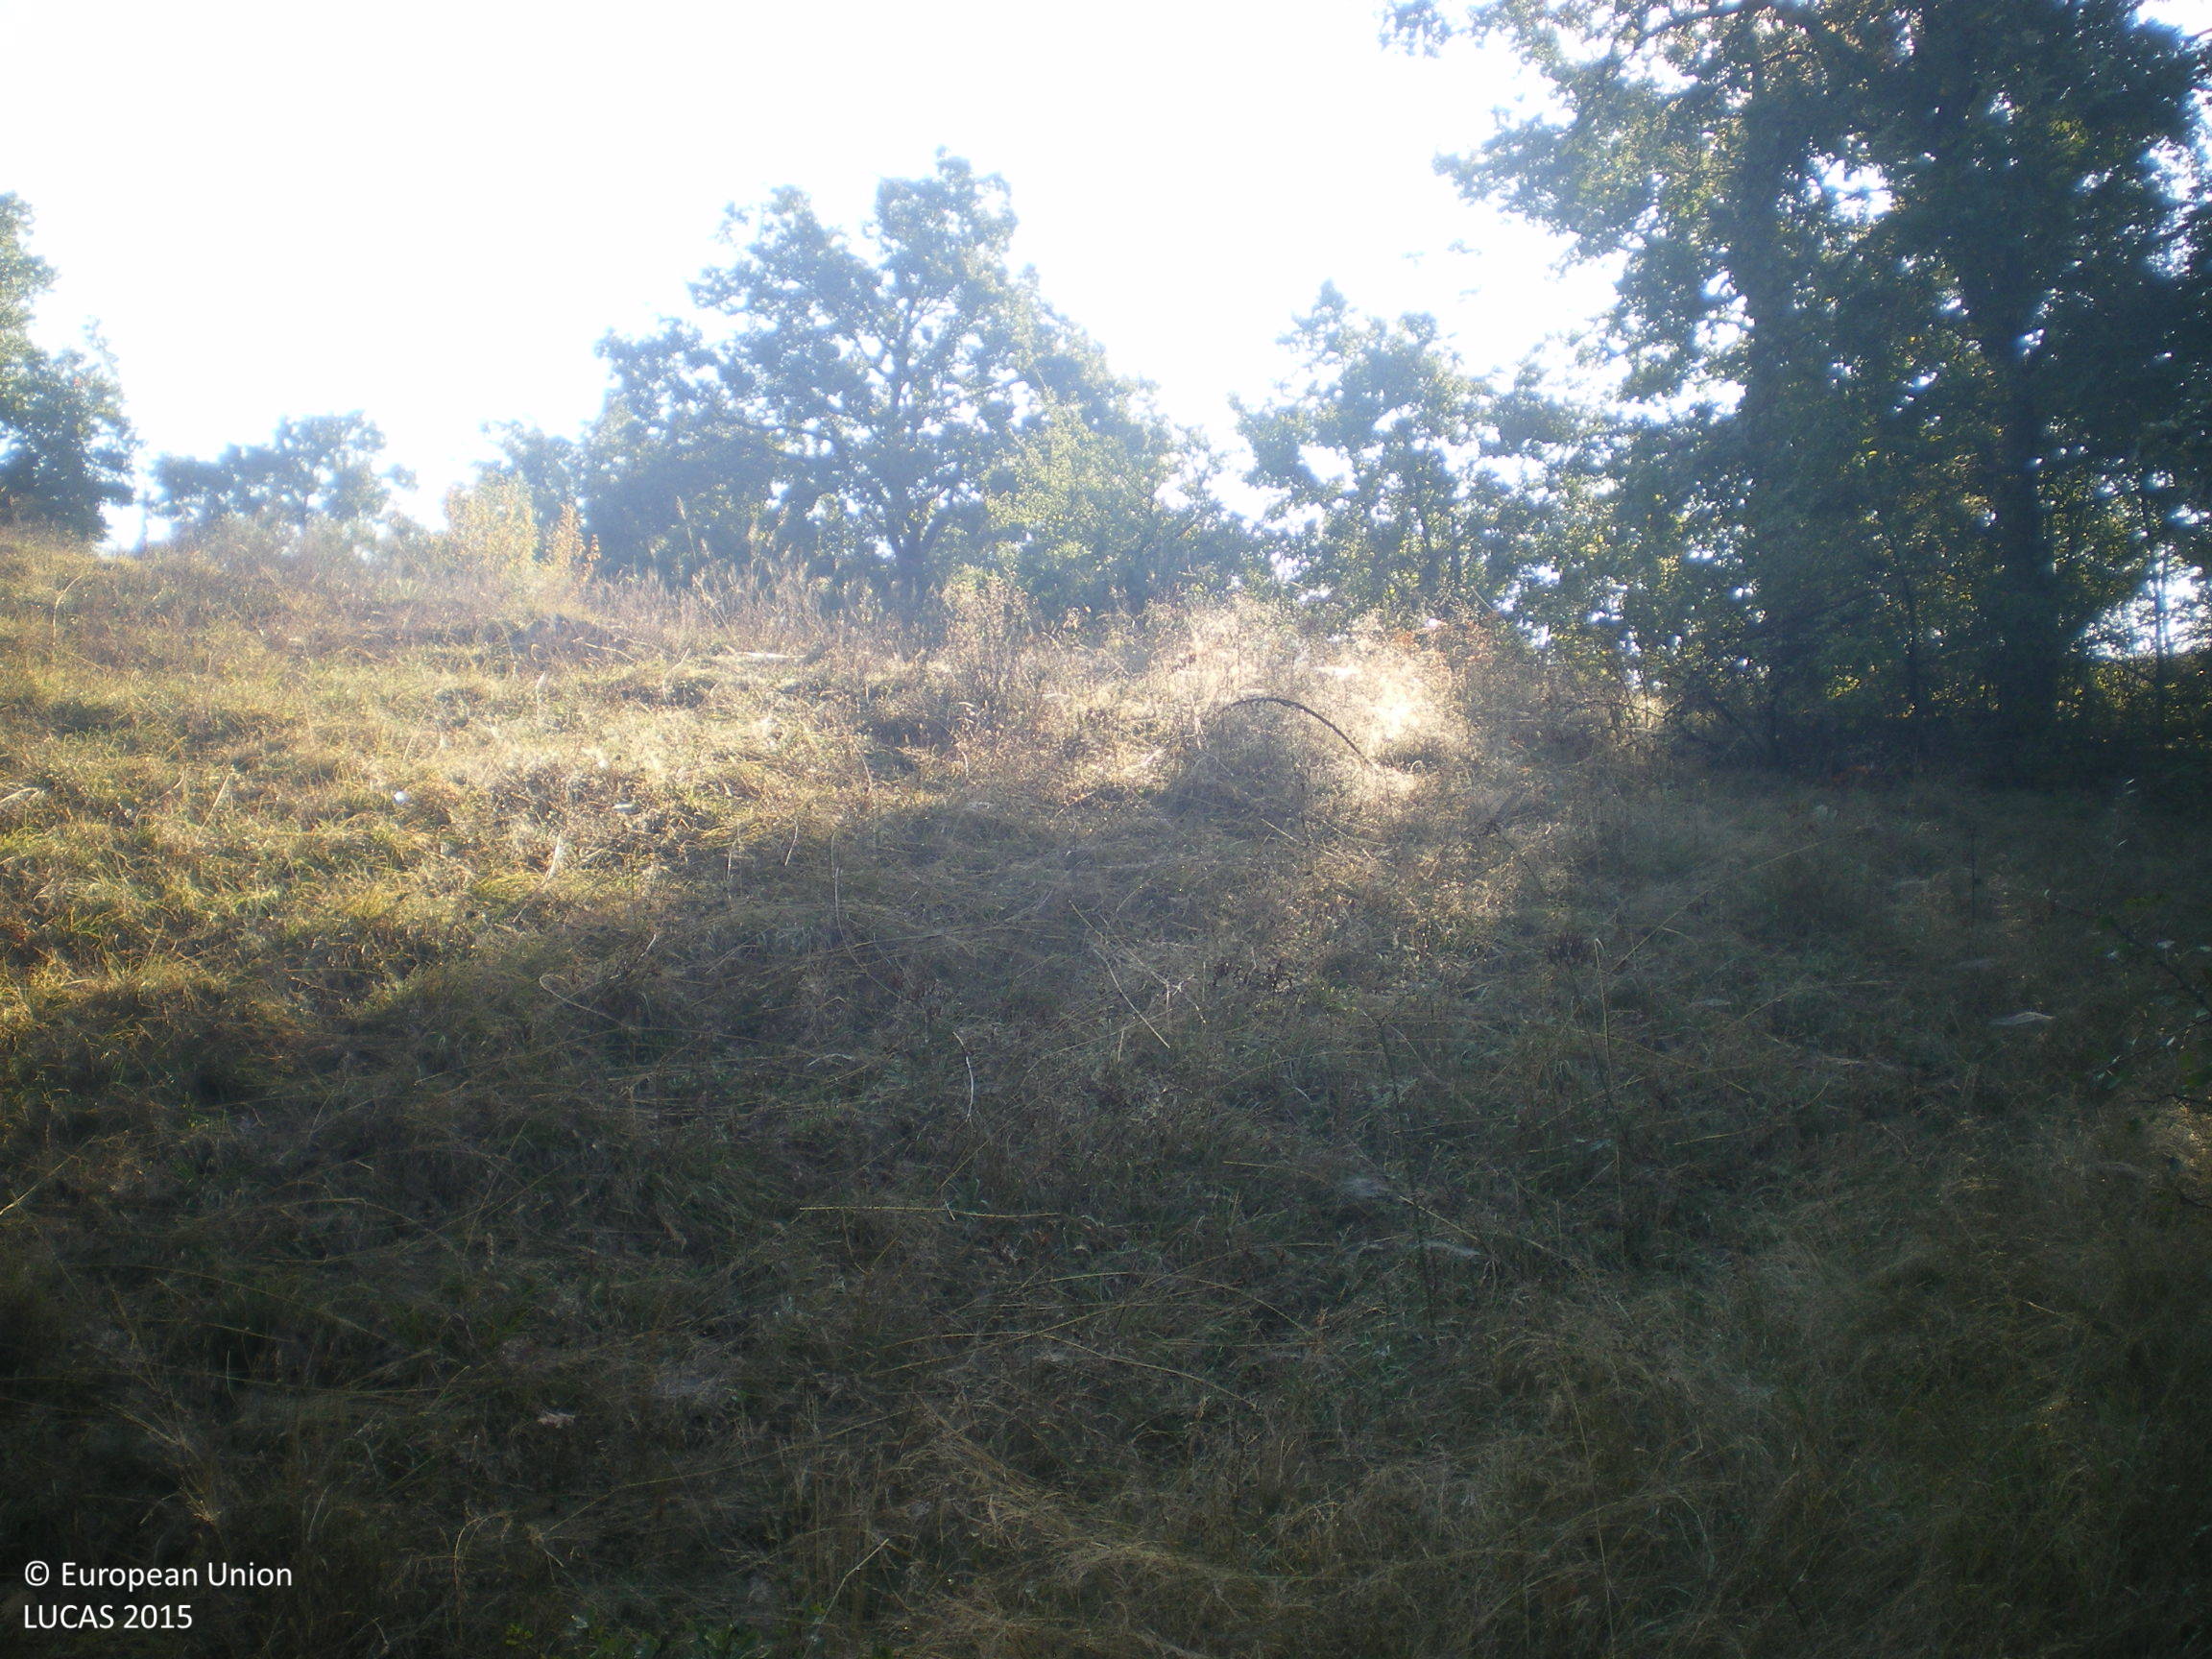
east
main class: Woodland
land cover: Broadleaved woodland
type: mesophytic deciduous forest
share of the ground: > 75 %
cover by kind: broadleaved forest trees 100 %
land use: Forestry
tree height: > 5 m
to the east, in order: Broadleaved woodland; Grassland with sparse tree/shrub cover; Broadleaved woodland; Grassland with sparse tree/shrub cover; Grassland without tree/shrub cover; Grassland with sparse tree/shrub cover; Tracks; Grassland with sparse tree/shrub cover; Tracks; Grassland with sparse tree/shrub cover
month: October
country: BG
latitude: 42.0335
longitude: 26.2297
